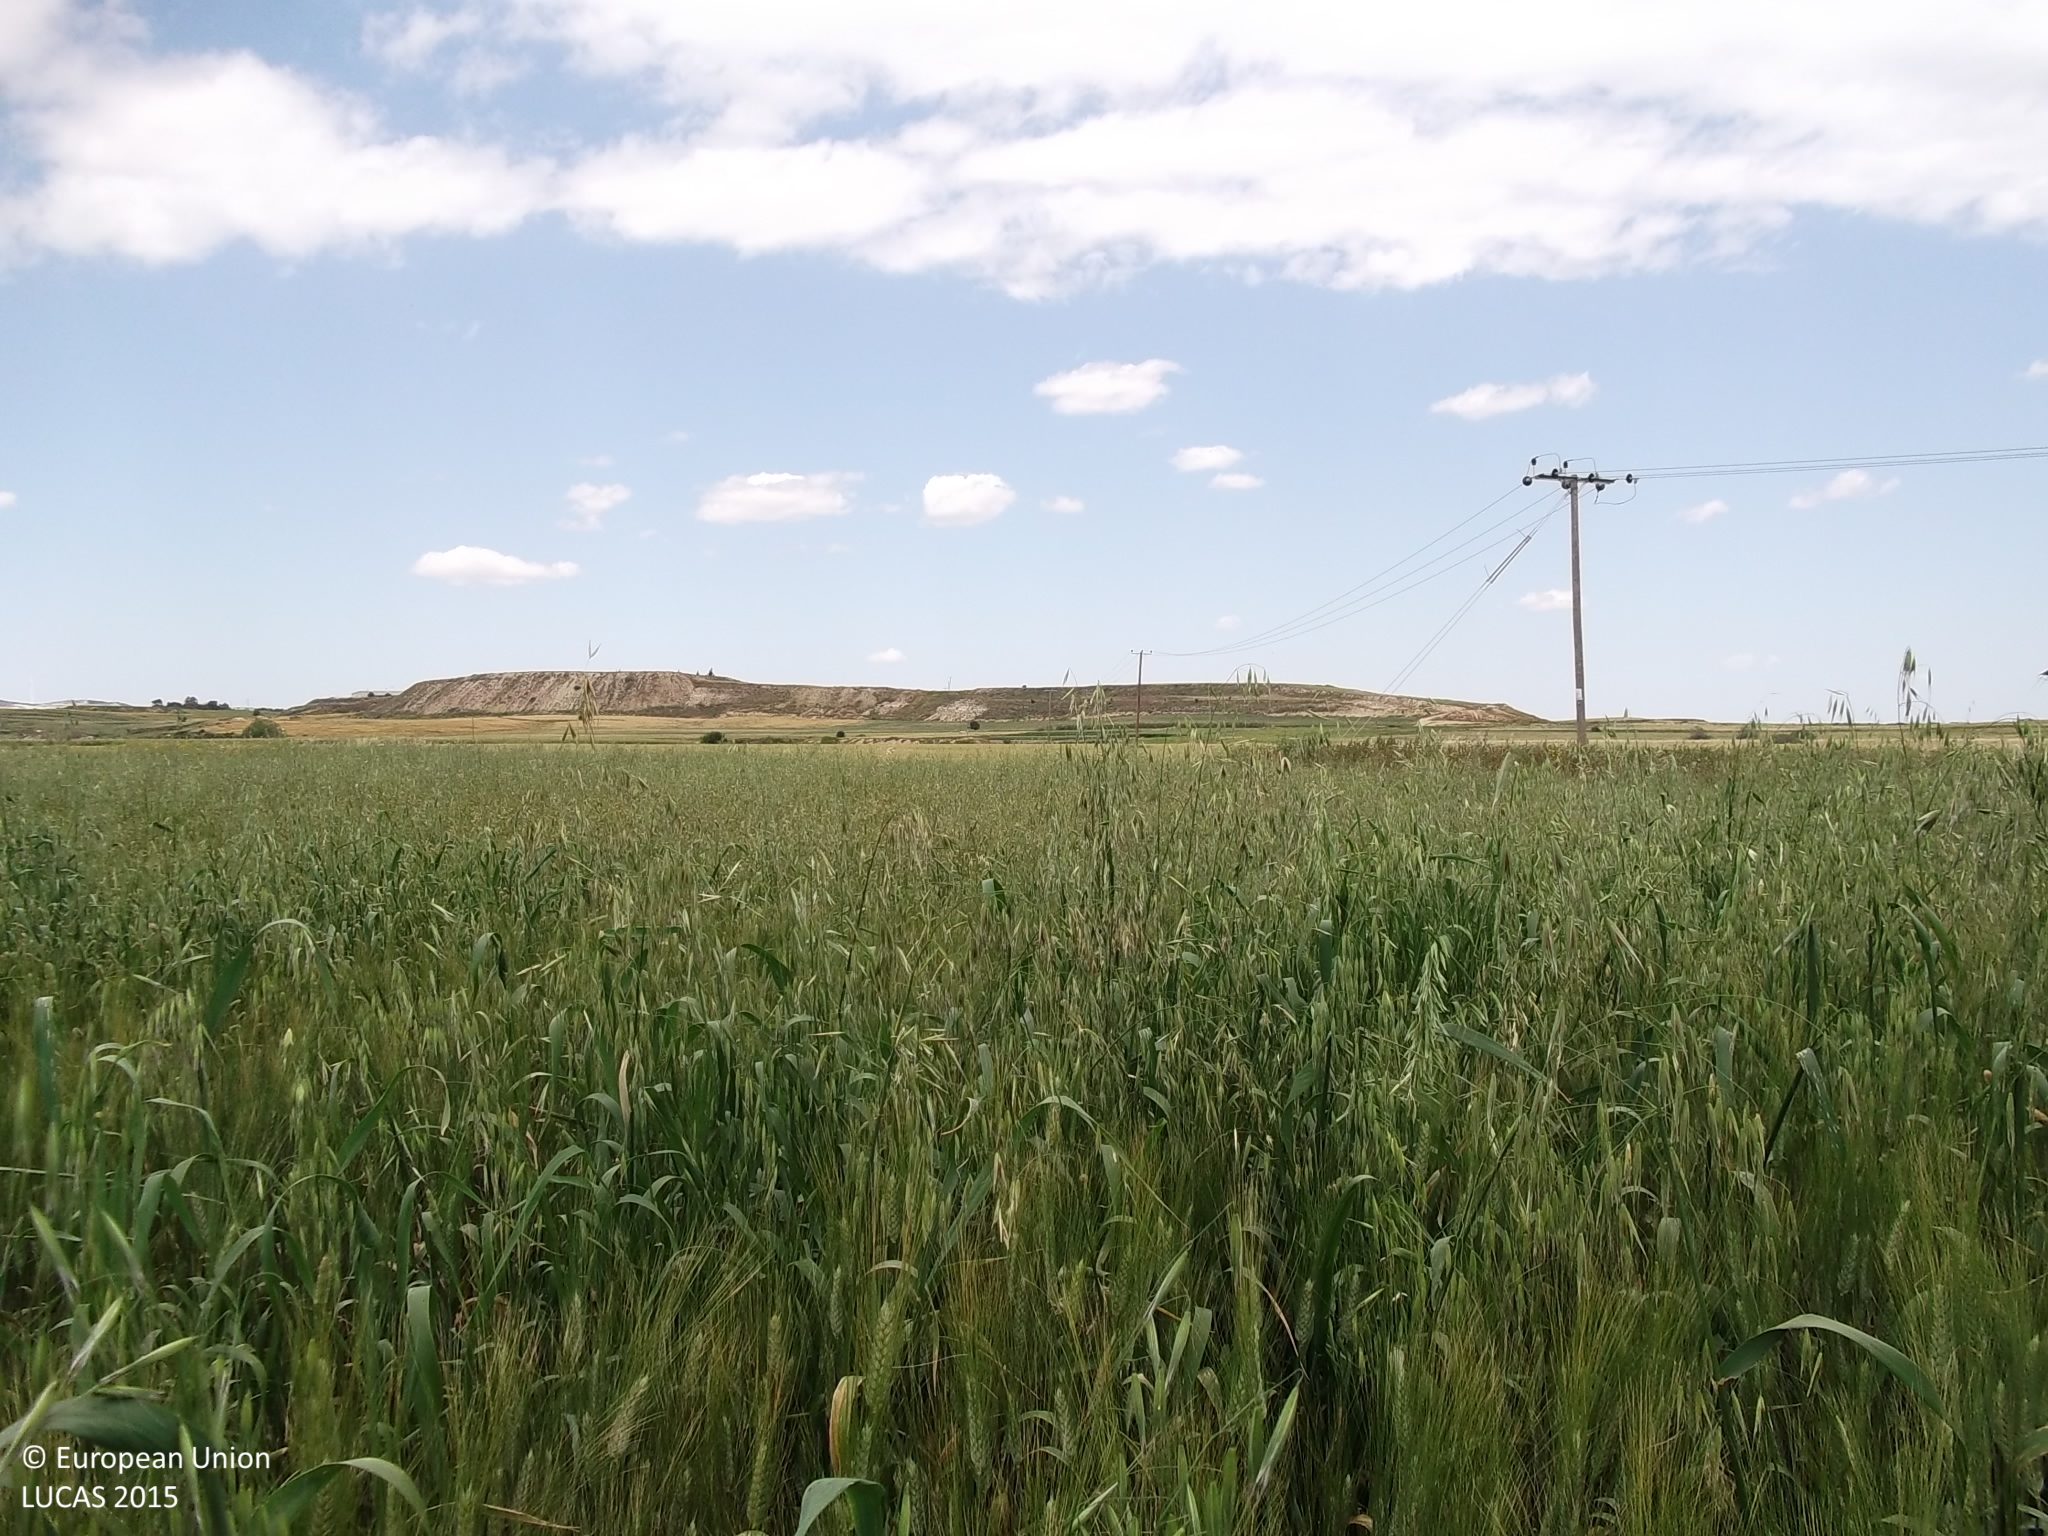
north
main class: Cropland
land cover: Barley
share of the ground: > 75 %
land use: Agriculture (excluding fallow land and kitchen gardens)
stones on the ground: < 10 %
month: April
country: CY
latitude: 34.8769
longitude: 33.5495
